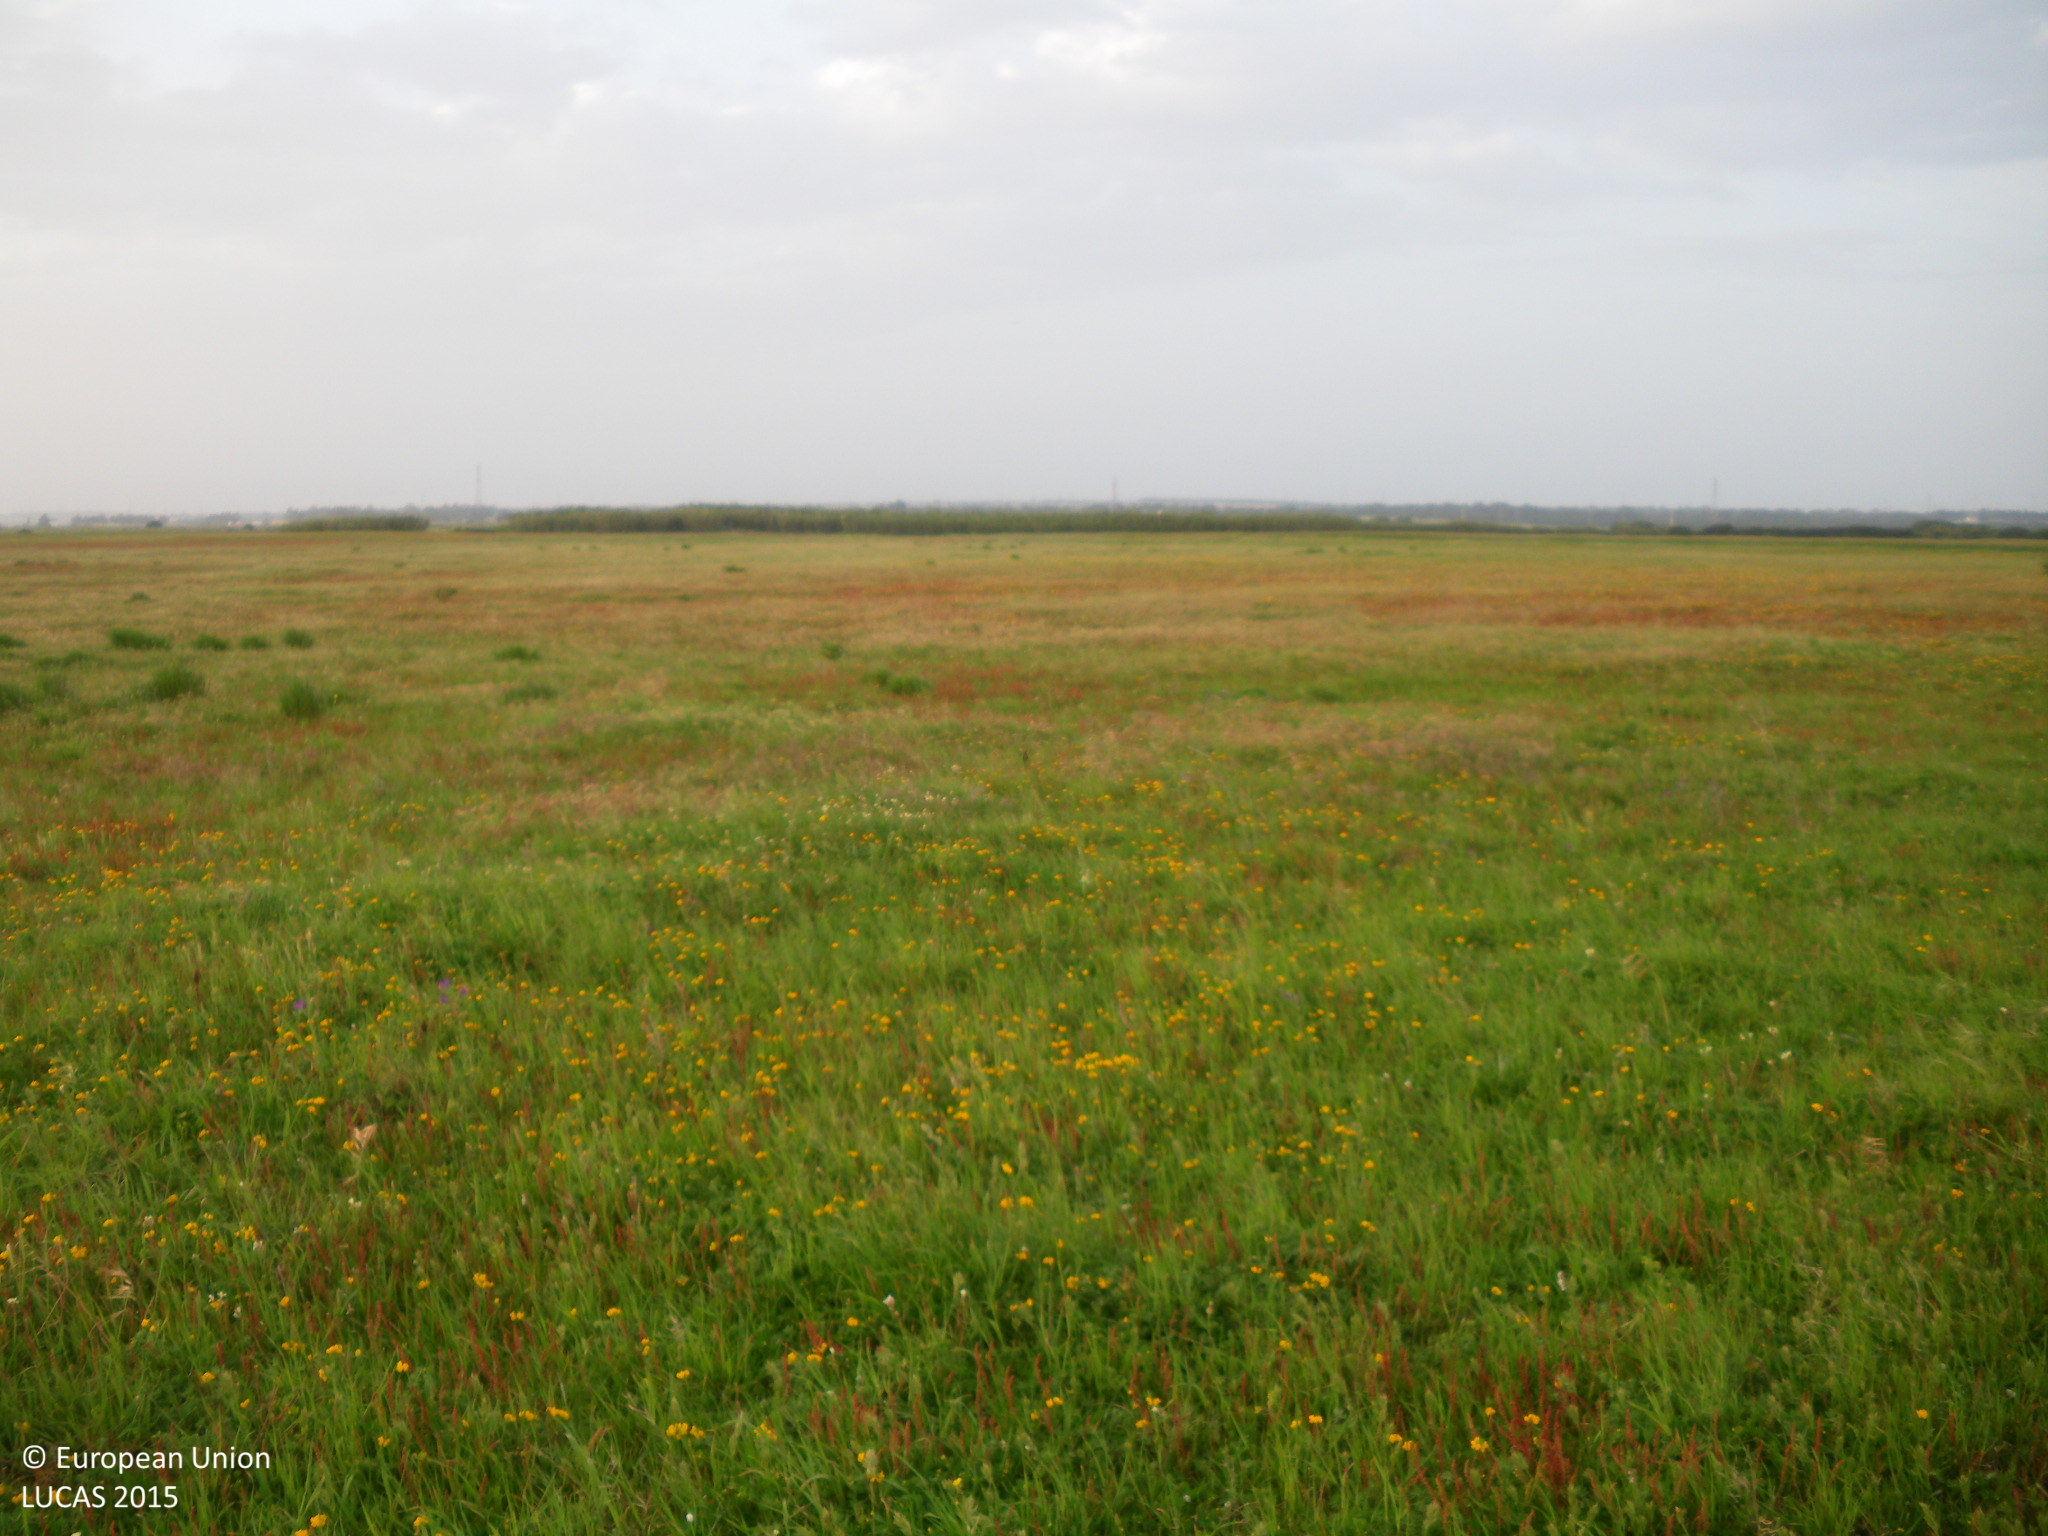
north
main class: Grassland
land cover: Spontaneously vegetated surfaces
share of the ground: > 75 %
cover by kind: herbaceous plants 100 %
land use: Fallow land
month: April
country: ES
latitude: 36.4707
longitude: -6.1342
